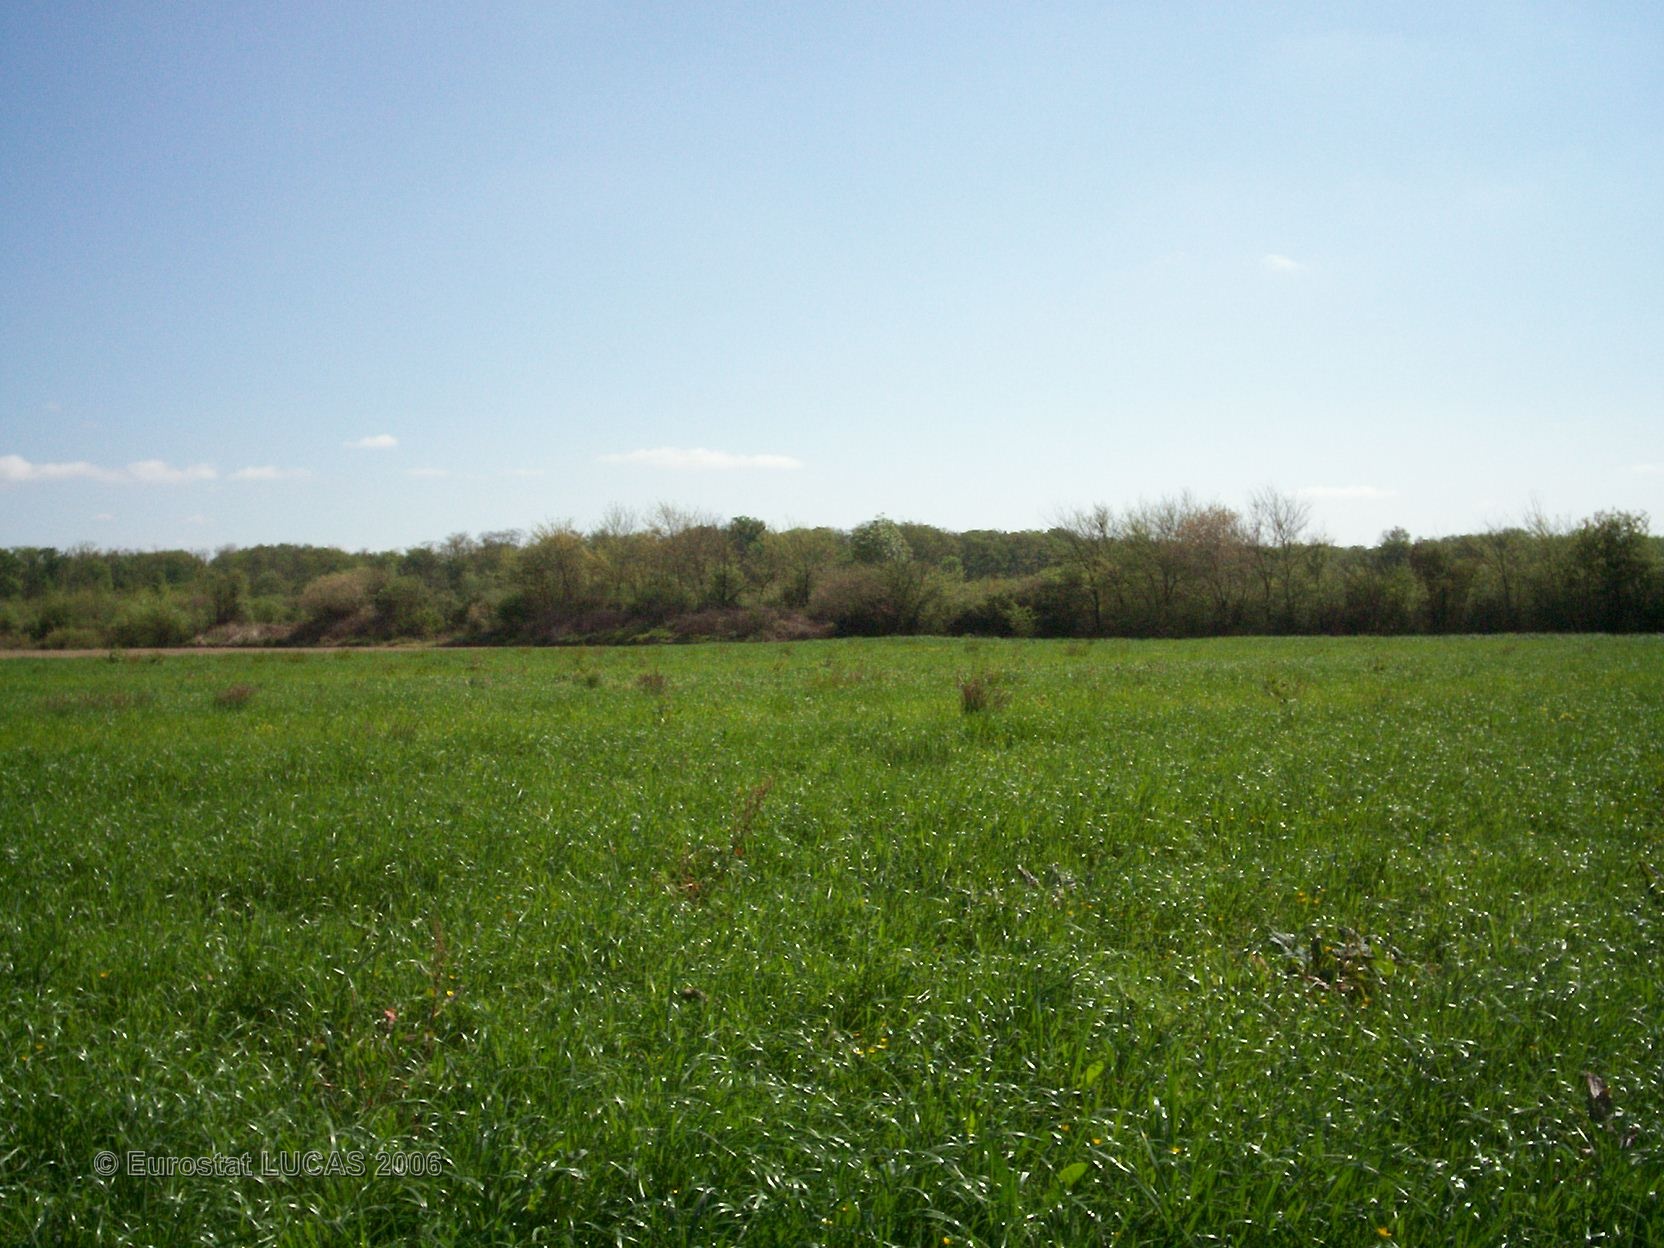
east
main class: Grassland
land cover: Grassland without tree/shrub cover
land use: Agriculture (excluding fallow land and kitchen gardens)
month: April
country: FR
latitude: 43.3840
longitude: -0.6376
